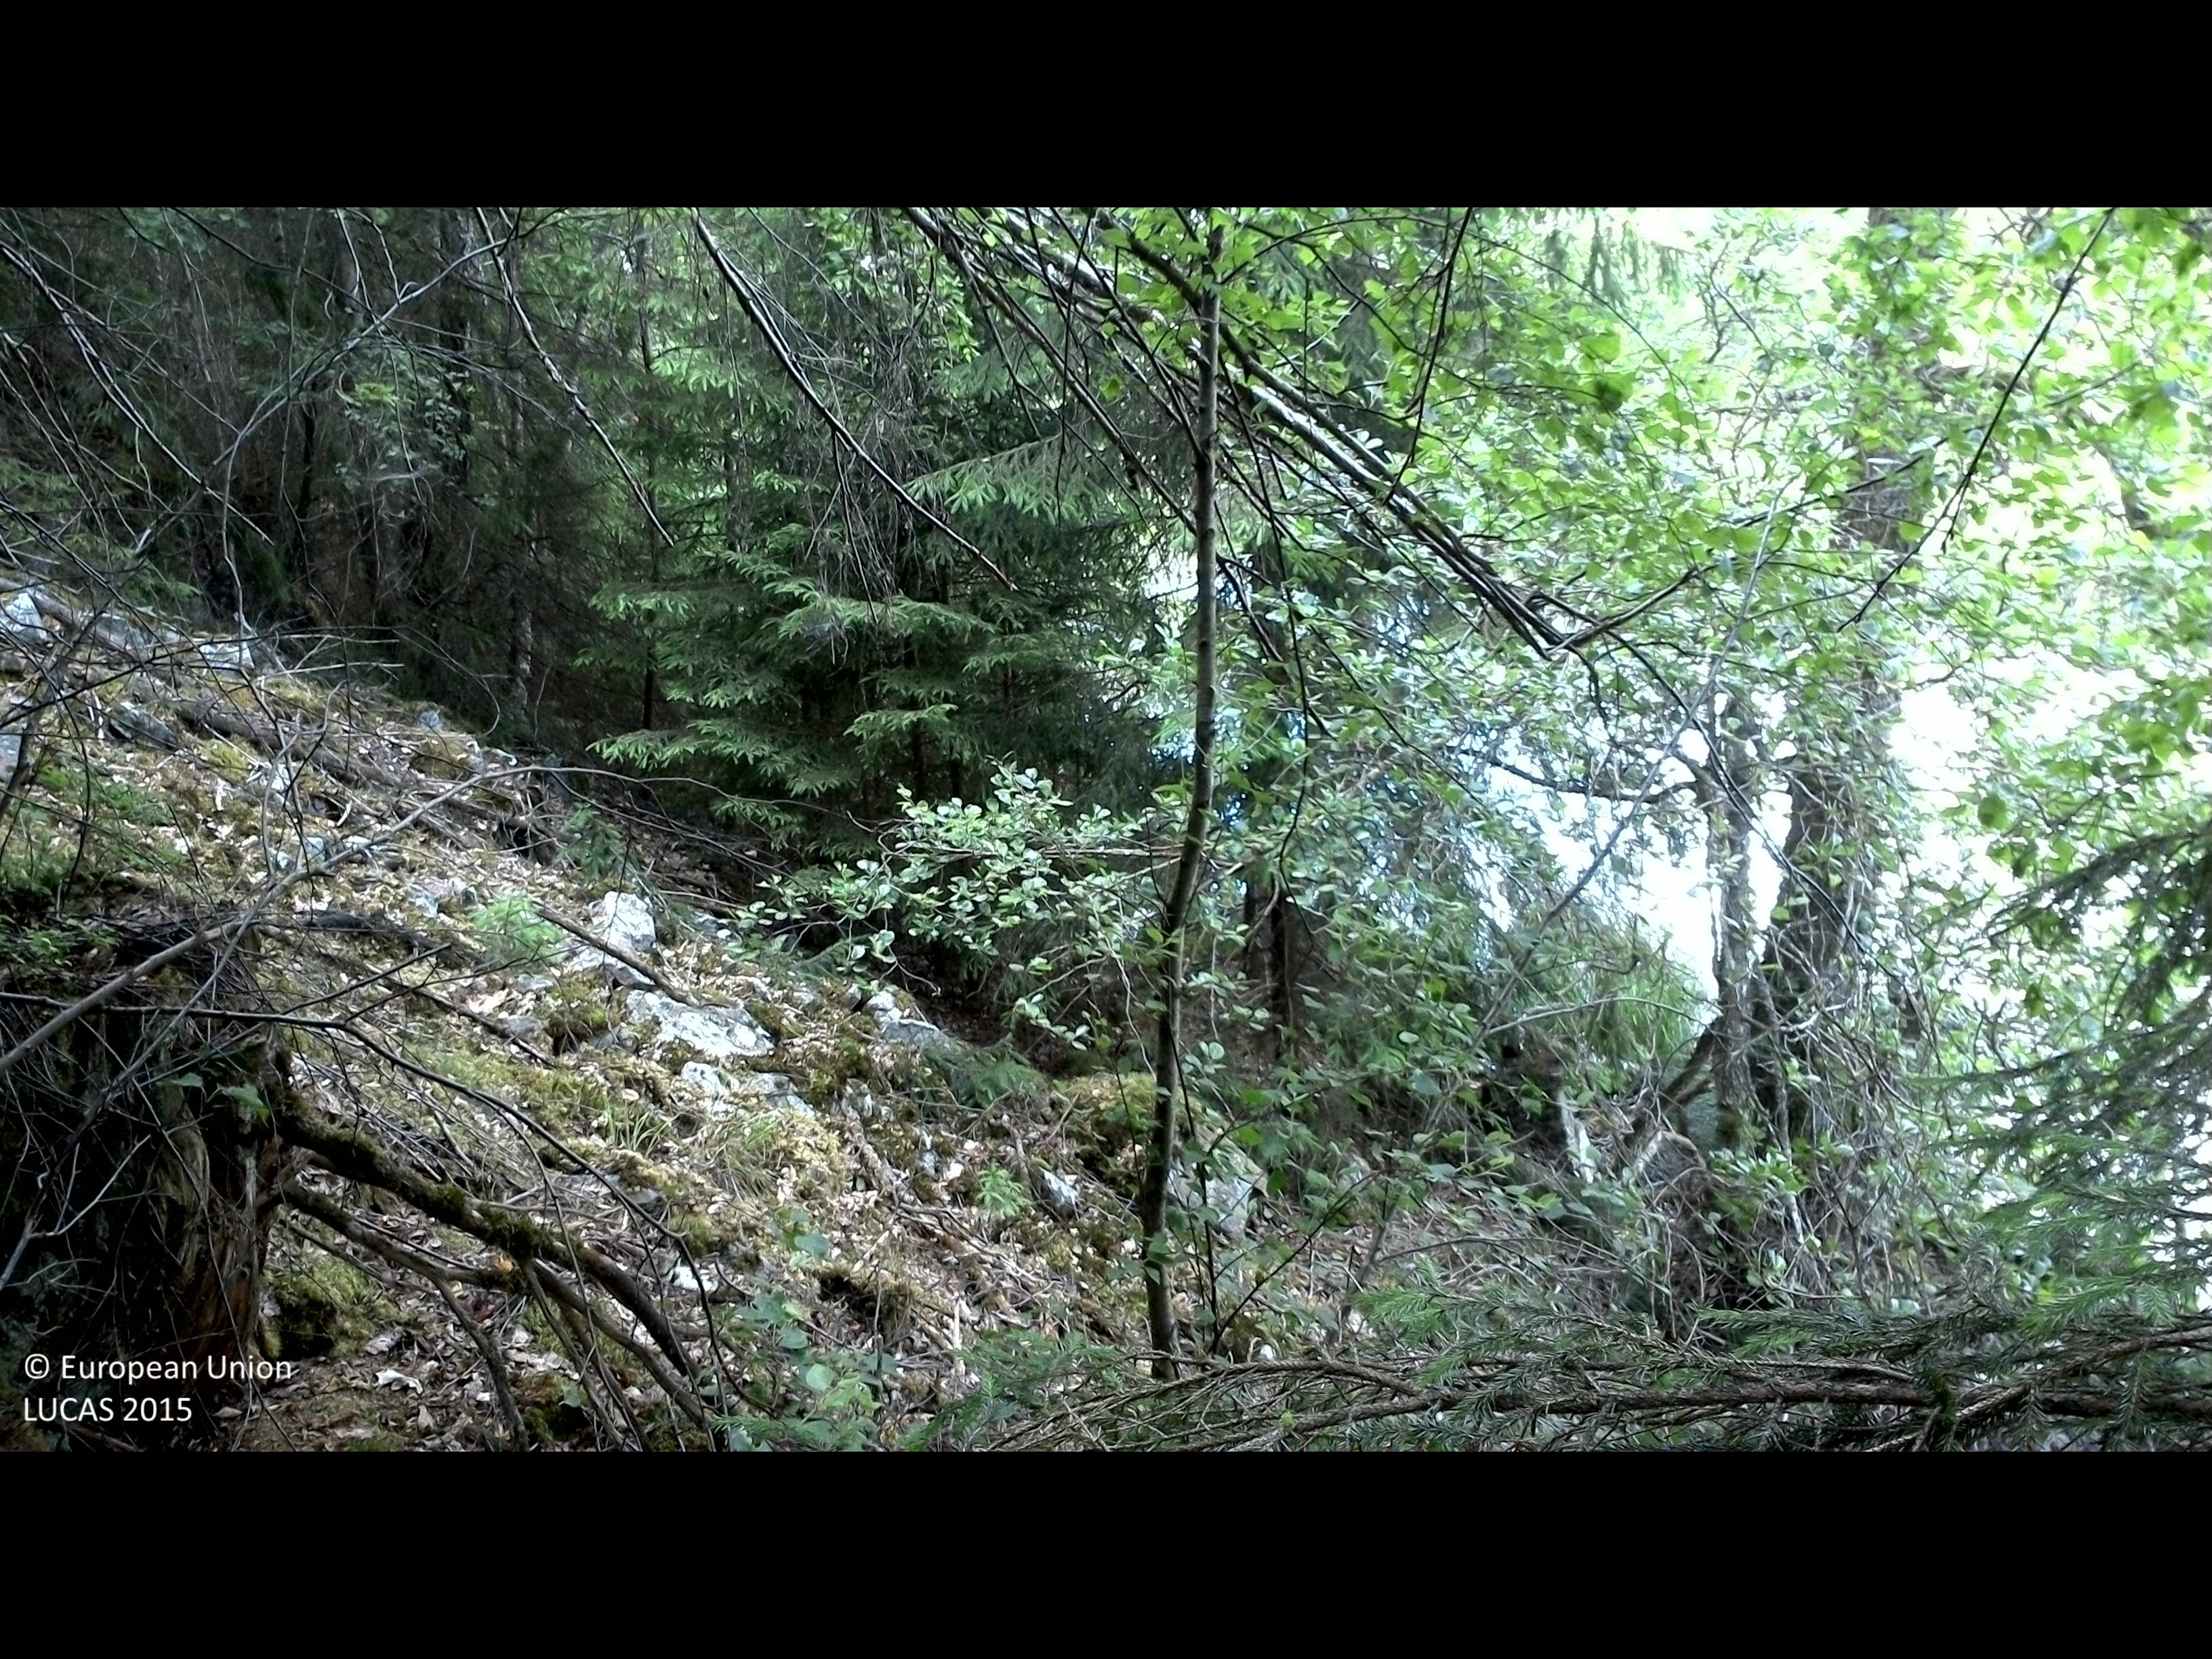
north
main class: Woodland
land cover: Spruce dominated coniferous woodland
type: boreal forest
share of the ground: > 75 %
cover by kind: coniferous forest trees 75 %, broadleaved forest trees 10 %, lichens and mosses 10 %, herbaceous plants 5 %
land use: Forestry
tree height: > 5 m
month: July
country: SE
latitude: 56.4144
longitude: 15.0068
